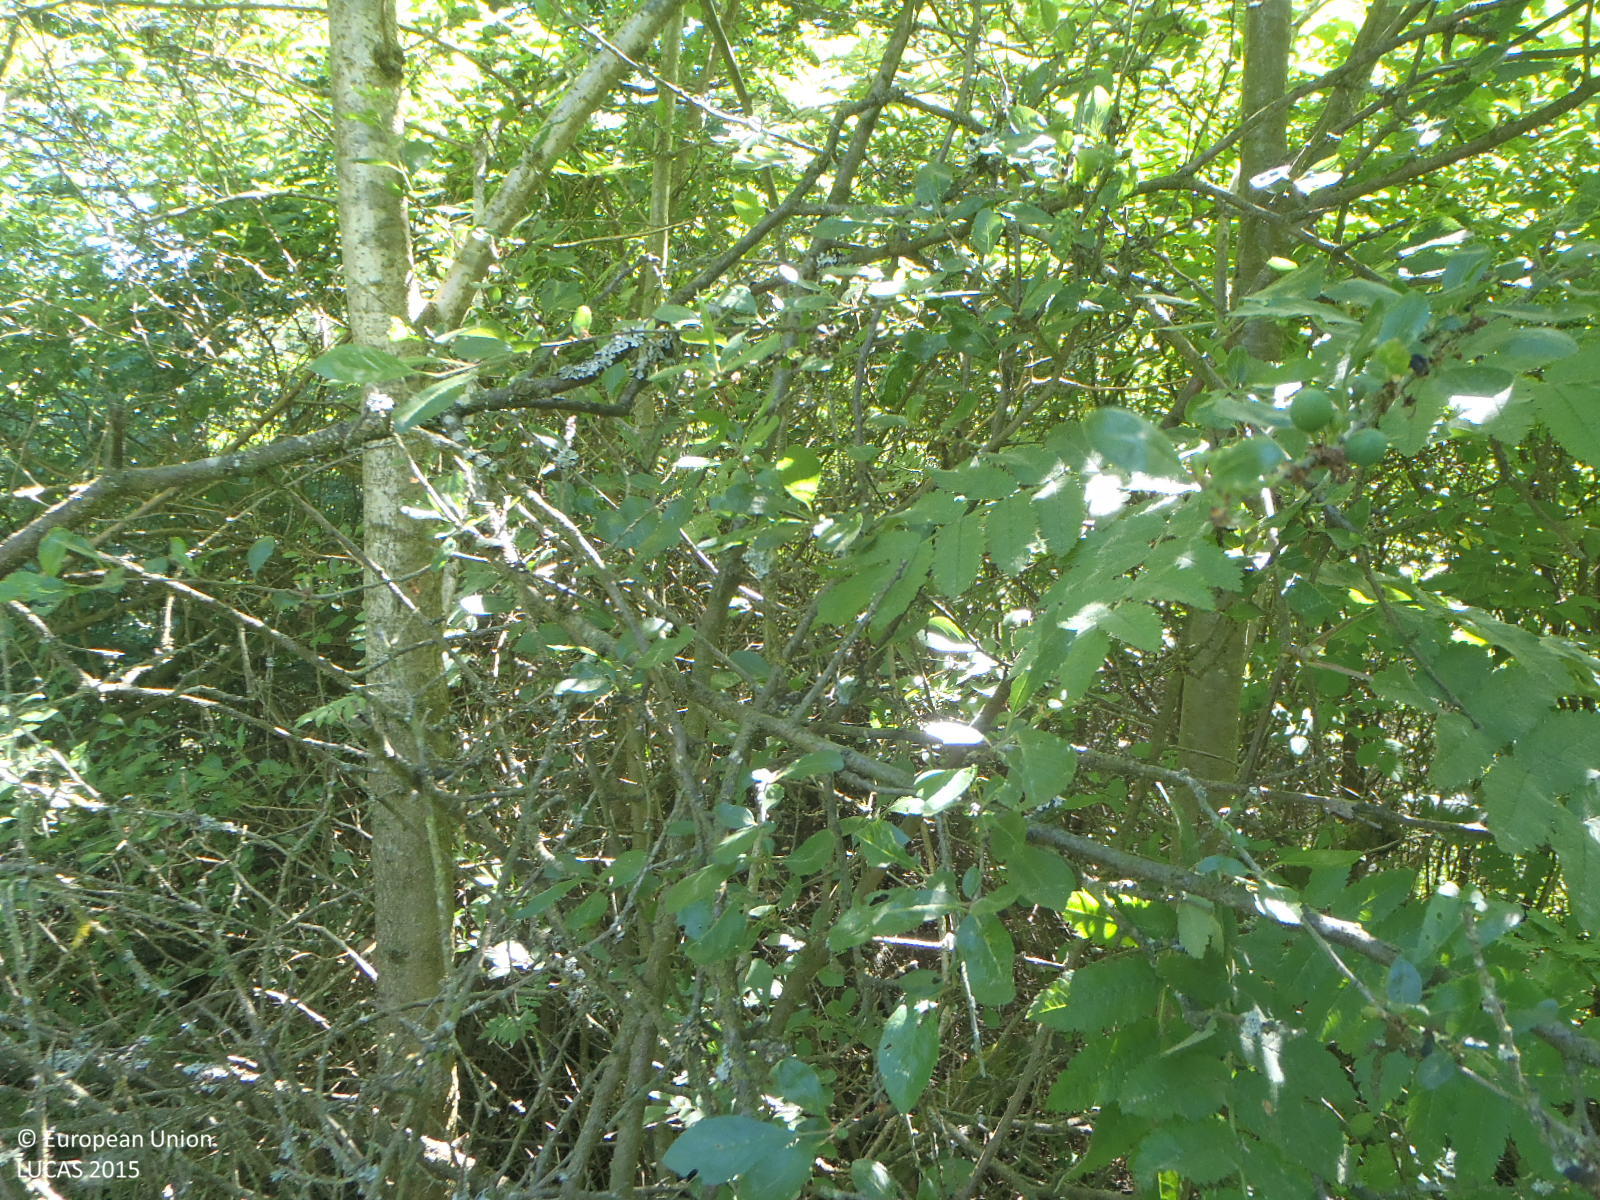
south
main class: Woodland
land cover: Broadleaved woodland
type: mesophytic deciduous forest
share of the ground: > 75 %
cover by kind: broadleaved forest trees 80 %, shrubs 15 %, herbaceous plants 5 %
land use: Semi-natural and natural areas not in use
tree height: > 5 m
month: June
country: CZ
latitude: 48.9564
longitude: 14.6037
